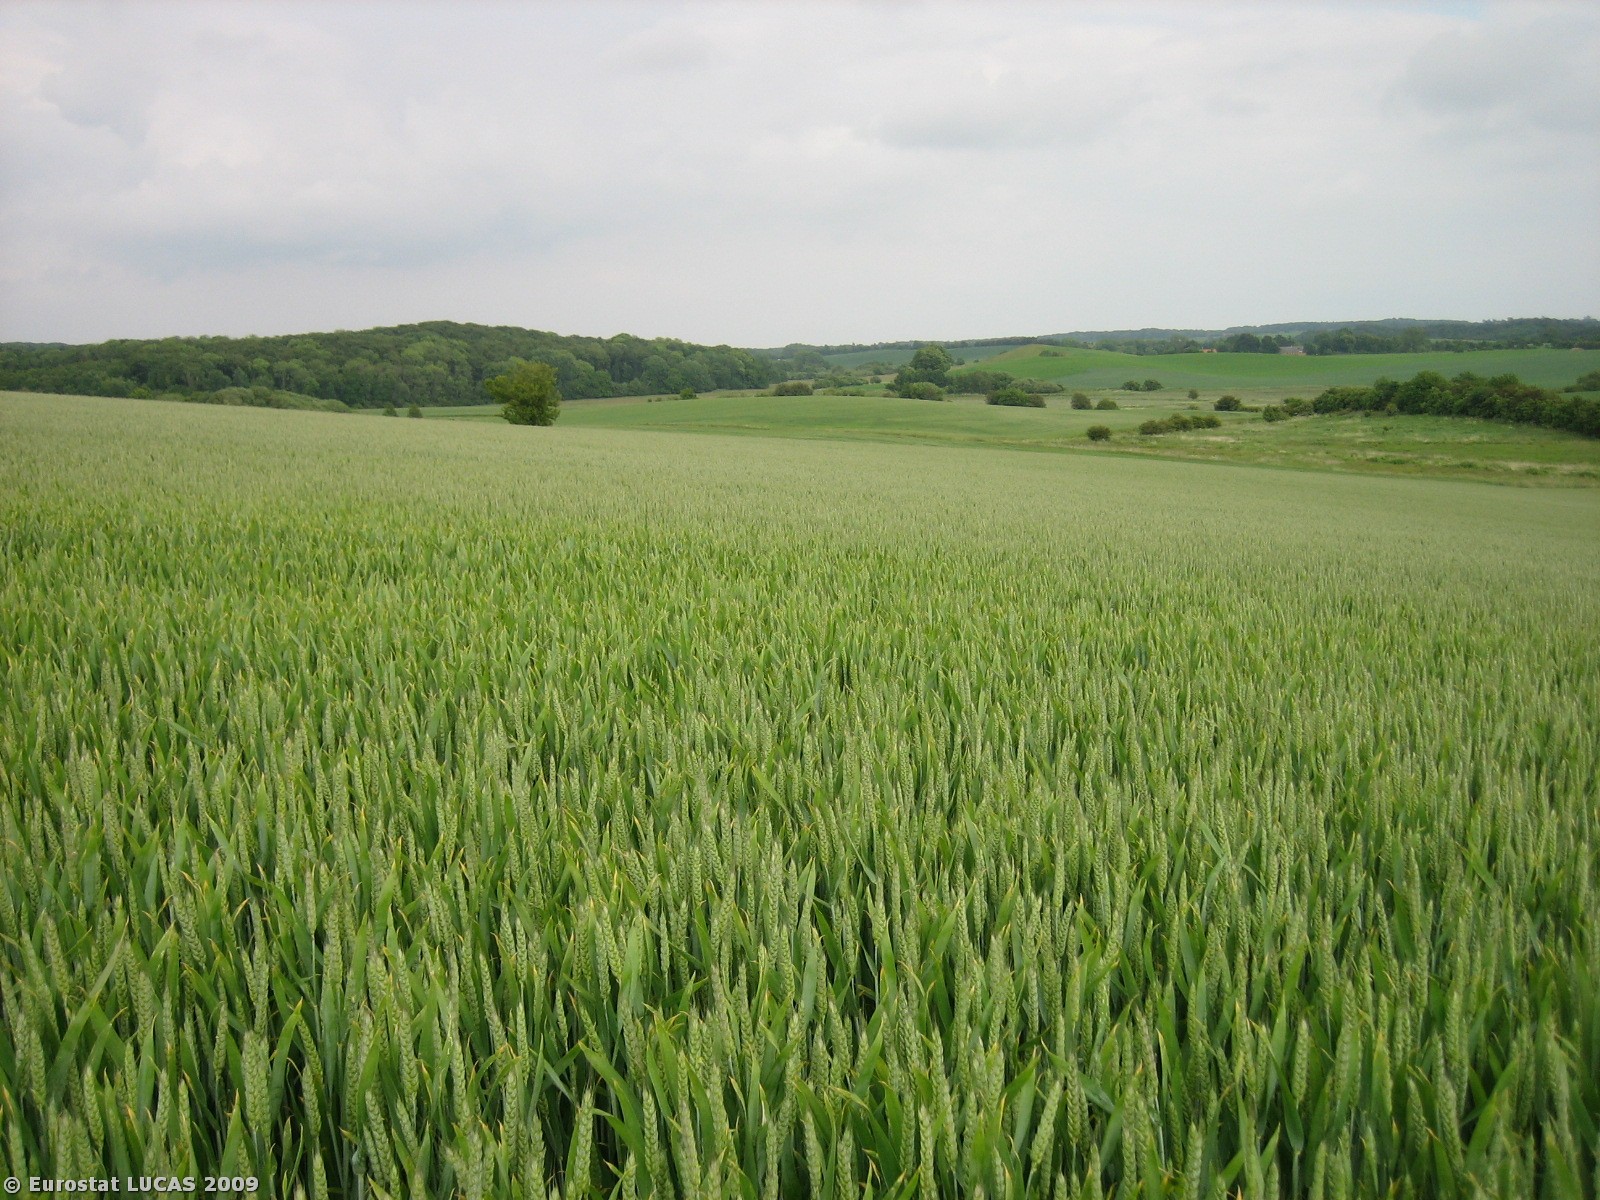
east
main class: Cropland
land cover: Common wheat
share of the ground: > 75 %
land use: Agriculture (excluding fallow land and kitchen gardens)
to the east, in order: Common wheat; Grass margins; Common wheat
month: June
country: DK
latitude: 56.0798
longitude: 10.1765
